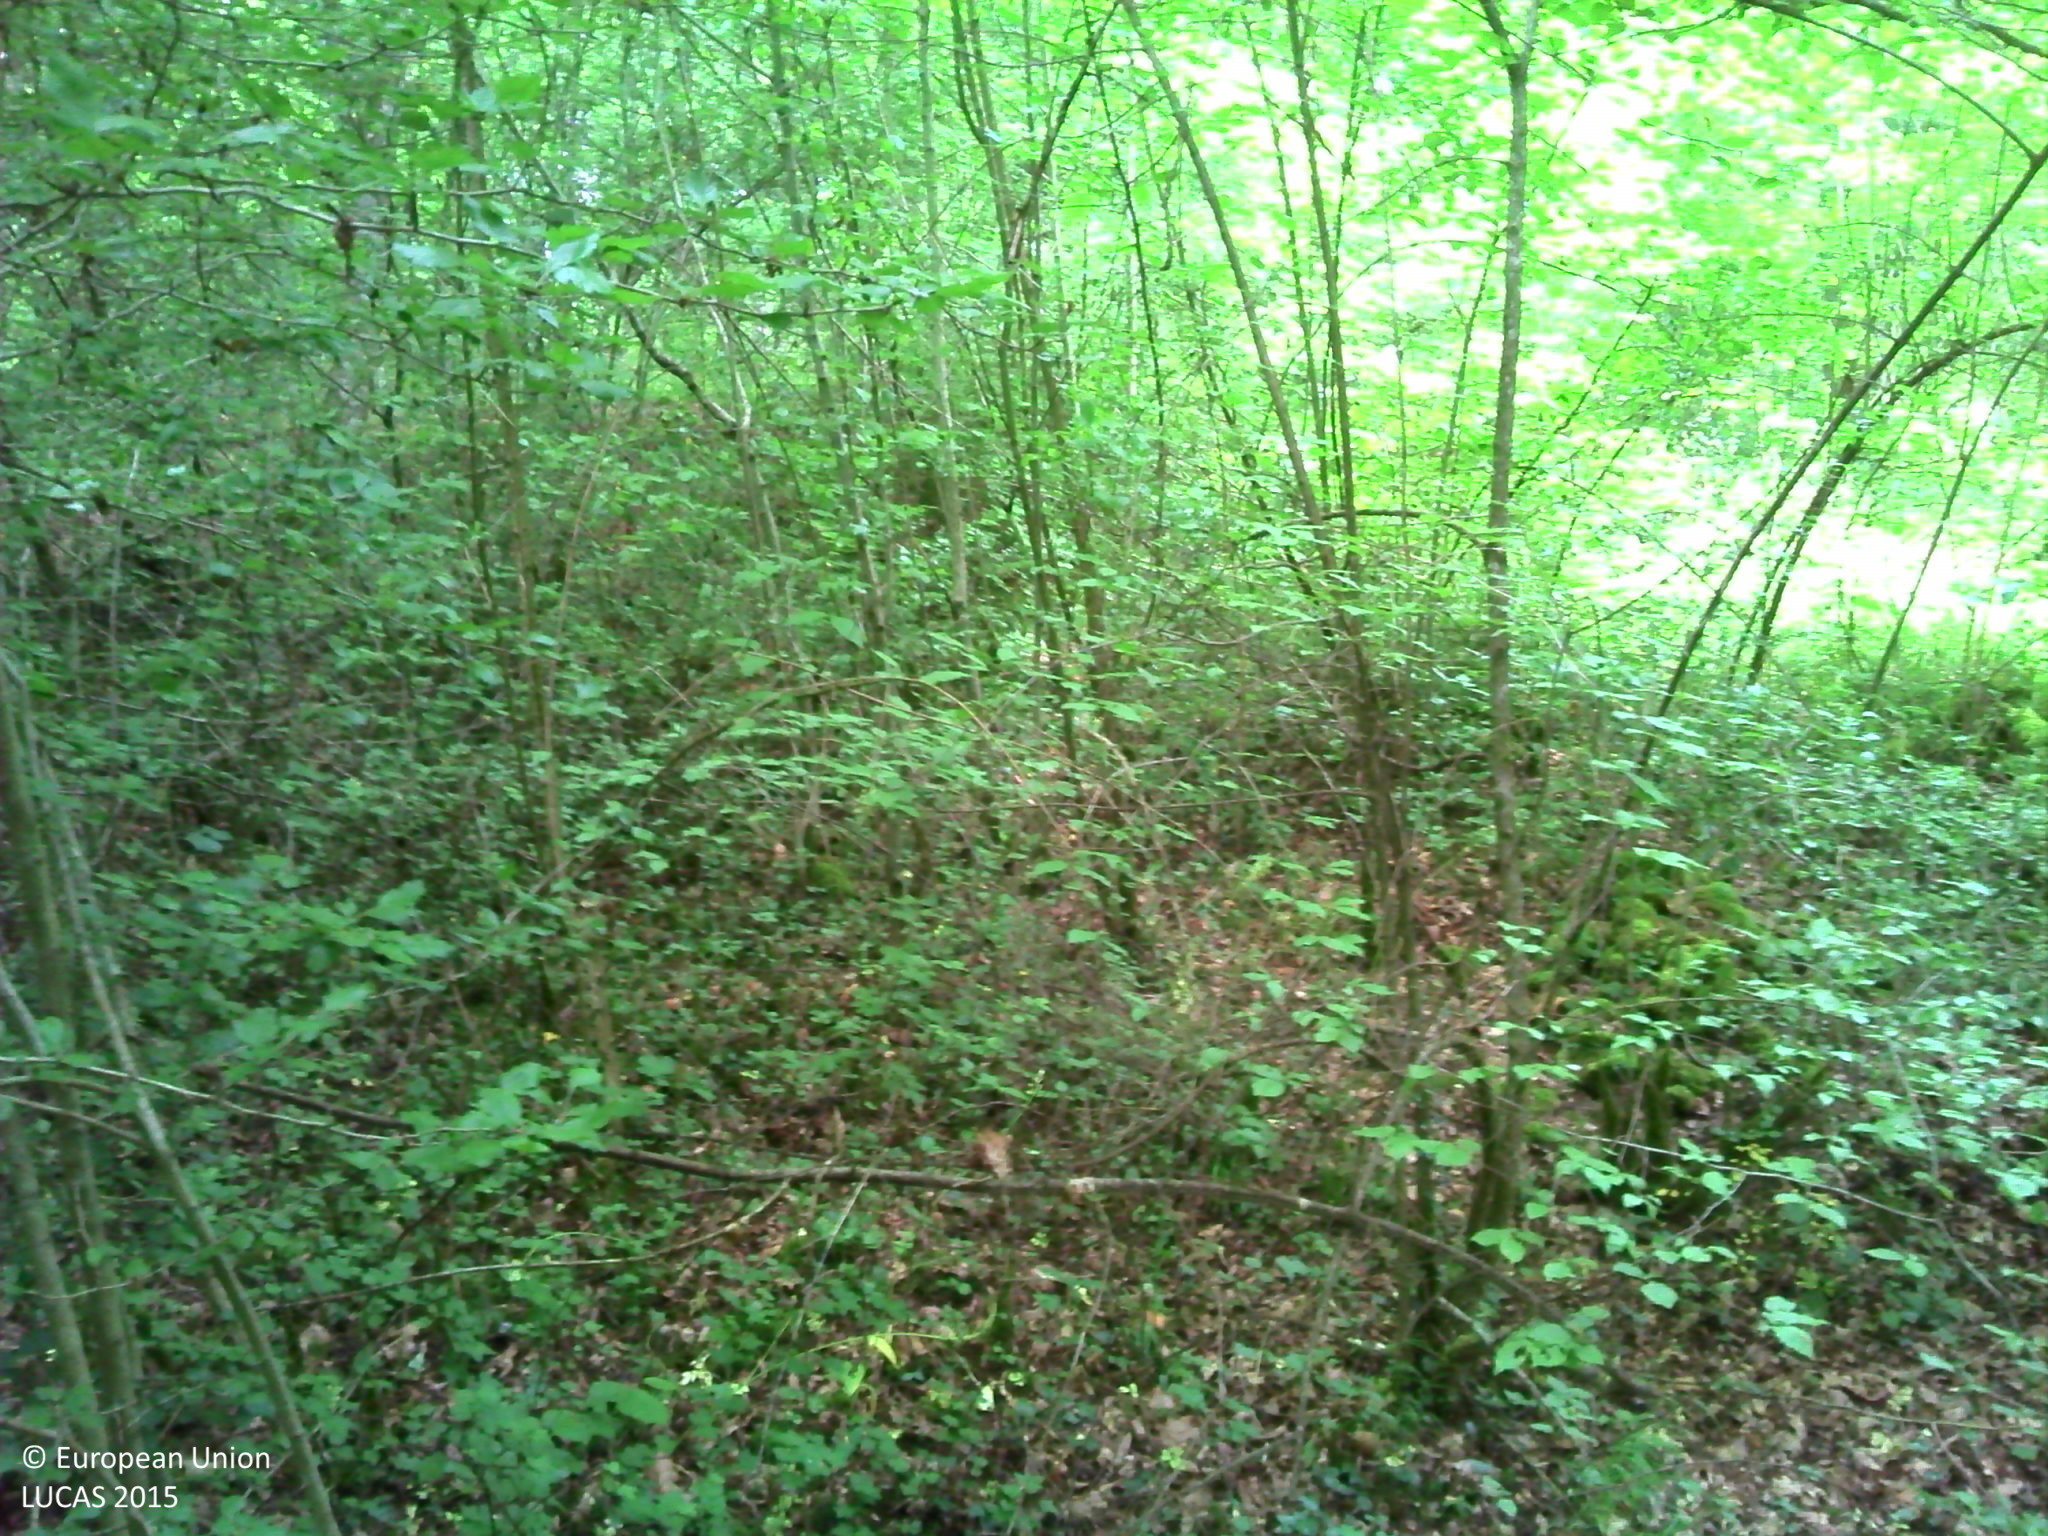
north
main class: Woodland
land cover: Broadleaved woodland
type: mesophytic deciduous forest
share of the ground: > 75 %
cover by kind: broadleaved forest trees 95 %, lichens and mosses 5 %
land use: Forestry
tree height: > 5 m
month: June
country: FR
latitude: 48.7111
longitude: 6.0451
